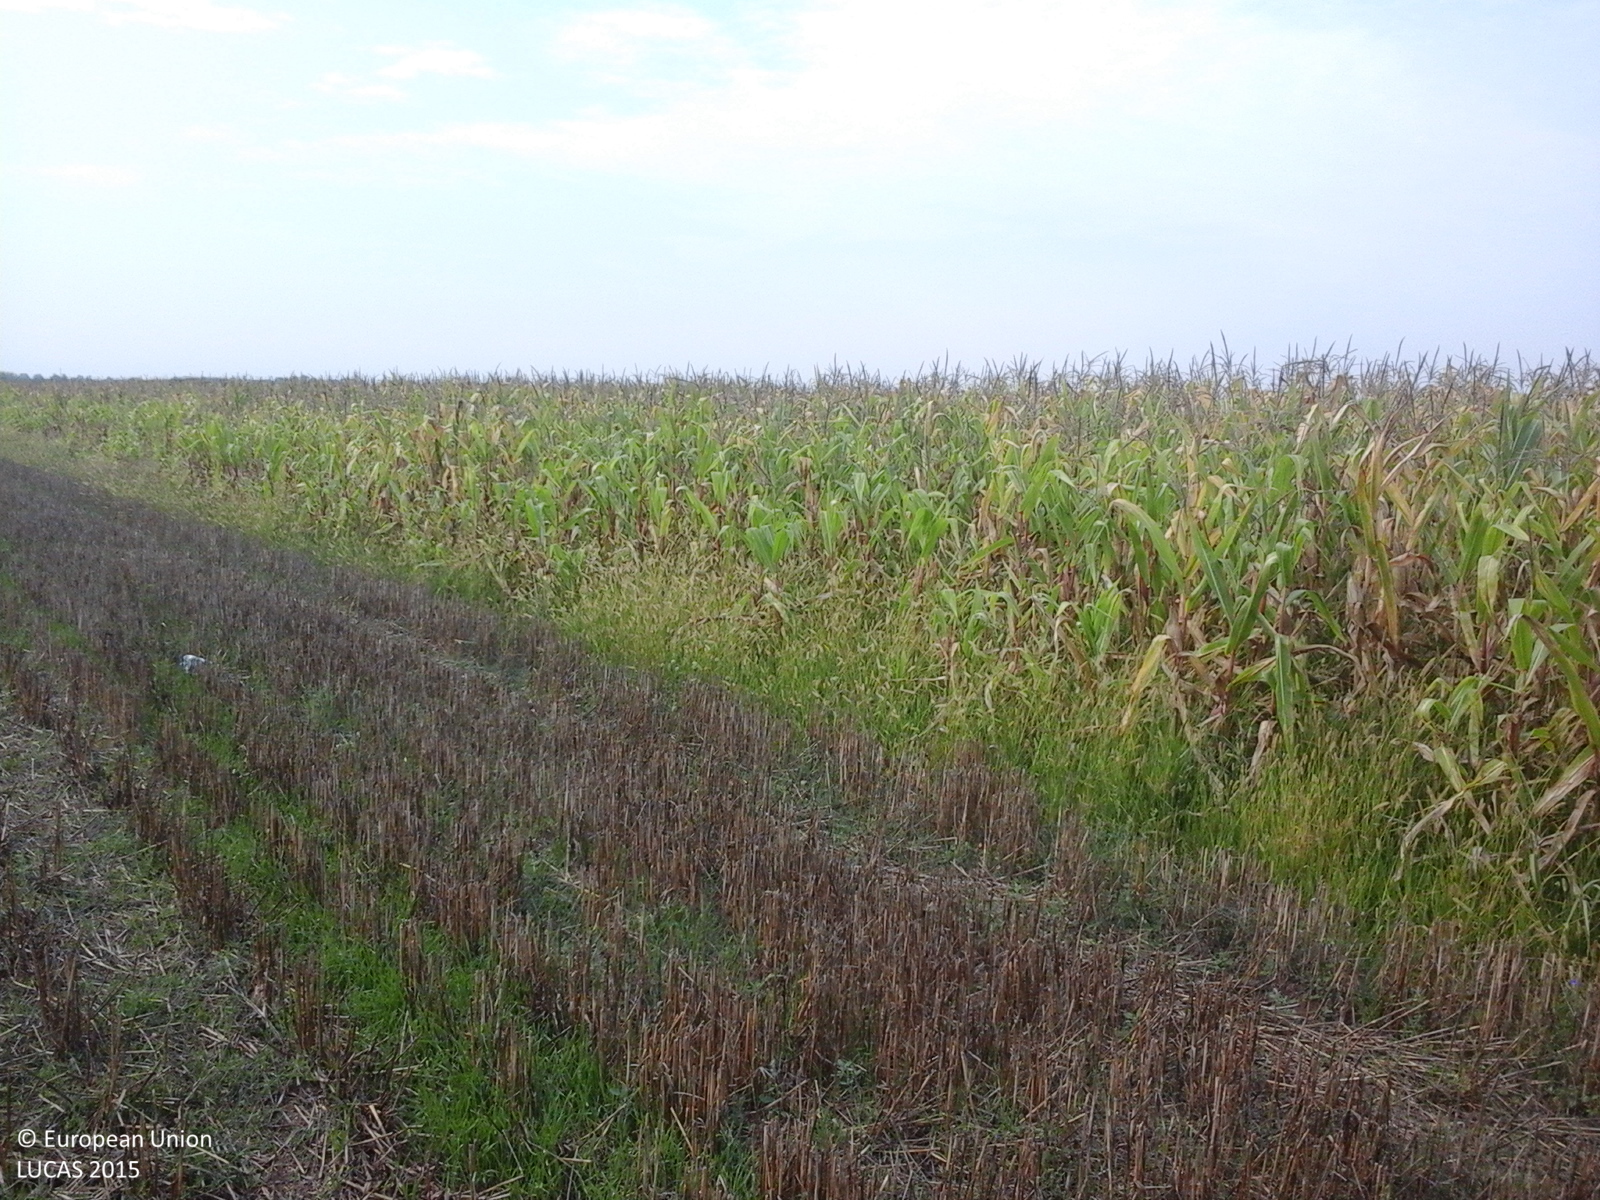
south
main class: Cropland
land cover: Durum wheat
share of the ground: > 75 %
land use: Agriculture (excluding fallow land and kitchen gardens)
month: August
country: RO
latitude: 46.5357
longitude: 21.6047
